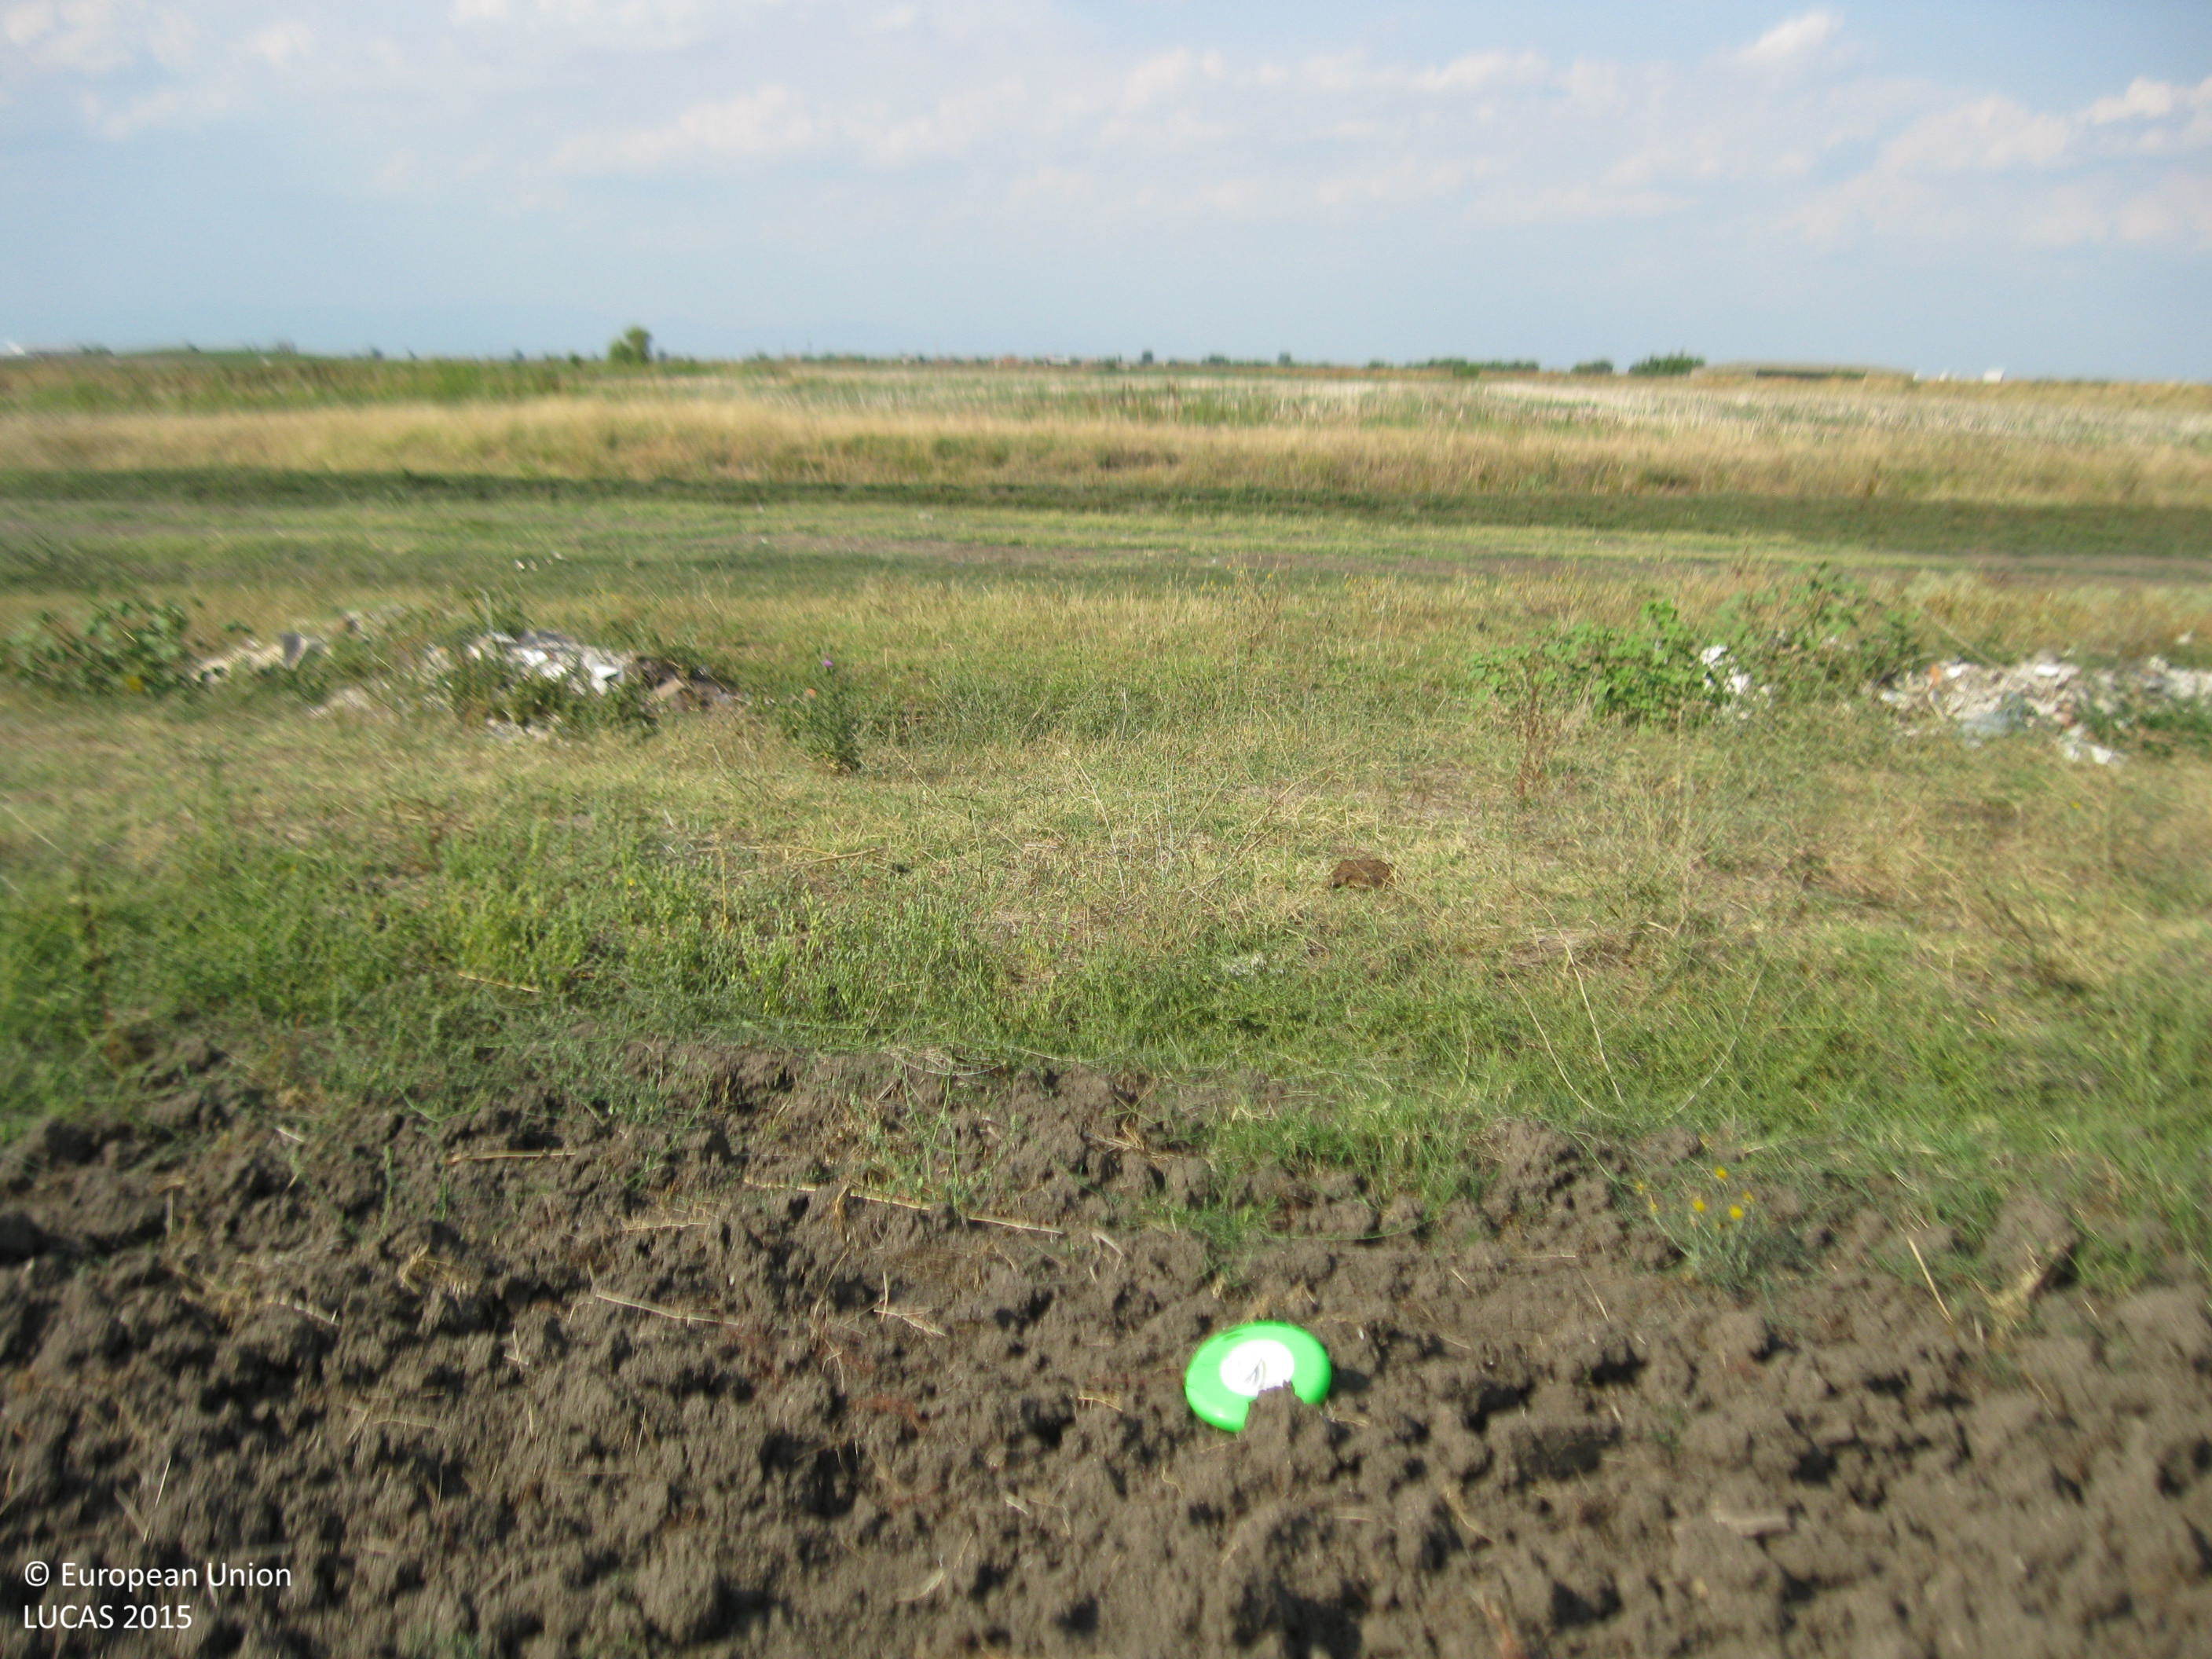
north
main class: Cropland
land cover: Rape and turnip rape
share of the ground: < 10 %
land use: Agriculture (excluding fallow land and kitchen gardens)
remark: Harvested field
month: August
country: BG
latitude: 42.1706
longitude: 24.6365
